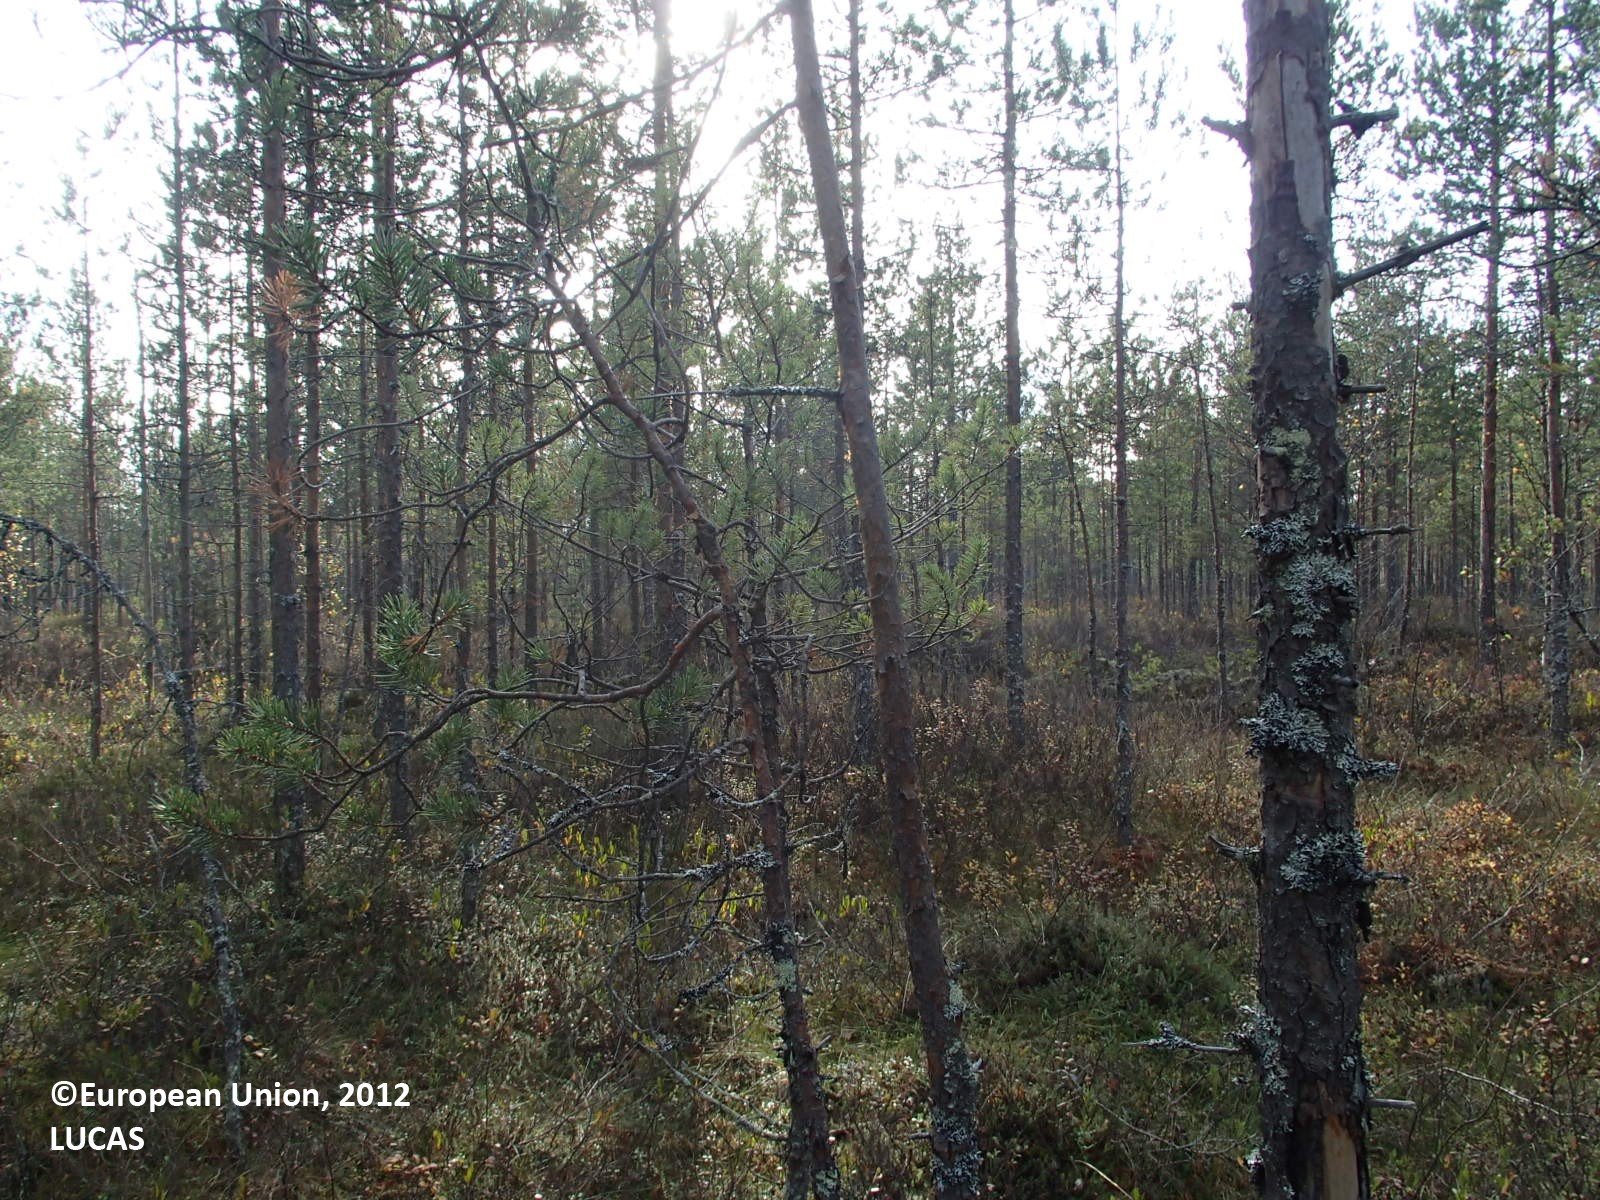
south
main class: Woodland
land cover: Pine dominated coniferous woodland
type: boreal forest
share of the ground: 50 - 75 %
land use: Forestry
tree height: > 5 m
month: September
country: FI
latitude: 63.6220
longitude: 26.1129
